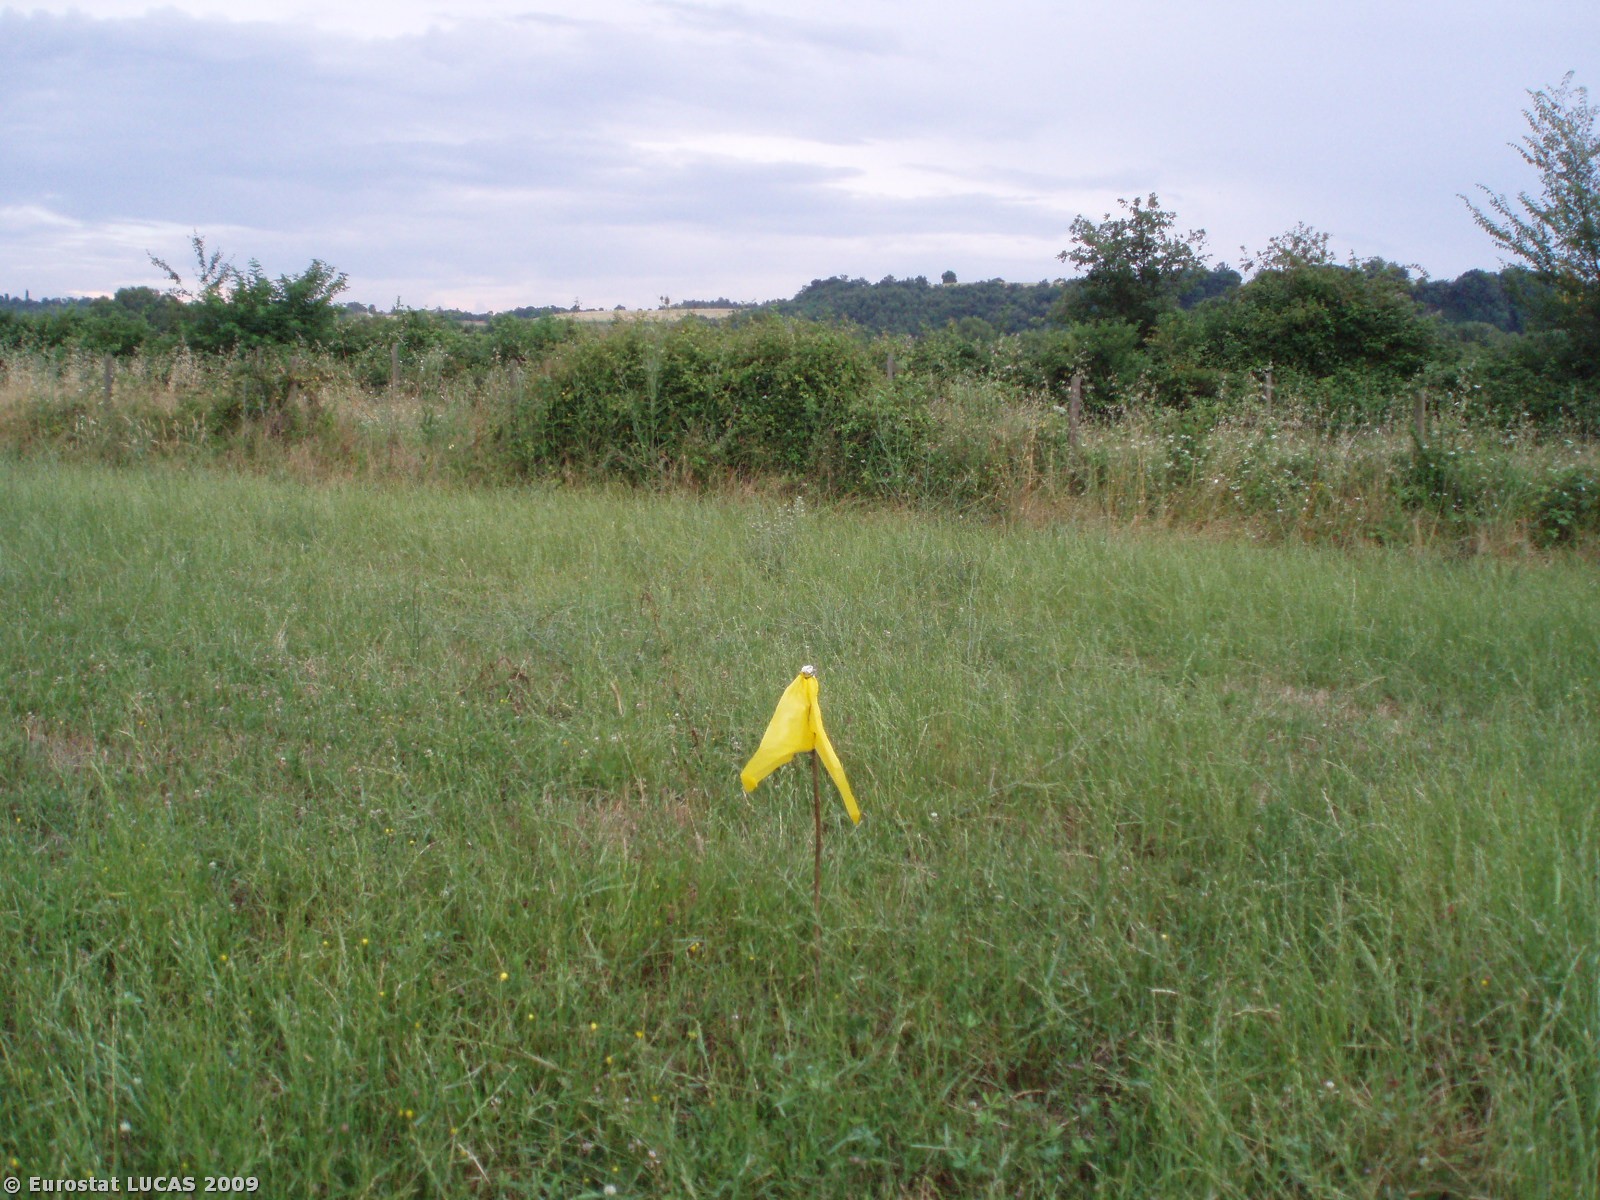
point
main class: Grassland
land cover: Grassland without tree/shrub cover
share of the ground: > 75 %
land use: Agriculture (excluding fallow land and kitchen gardens)
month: June
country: IT
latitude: 42.6415
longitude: 11.5924
